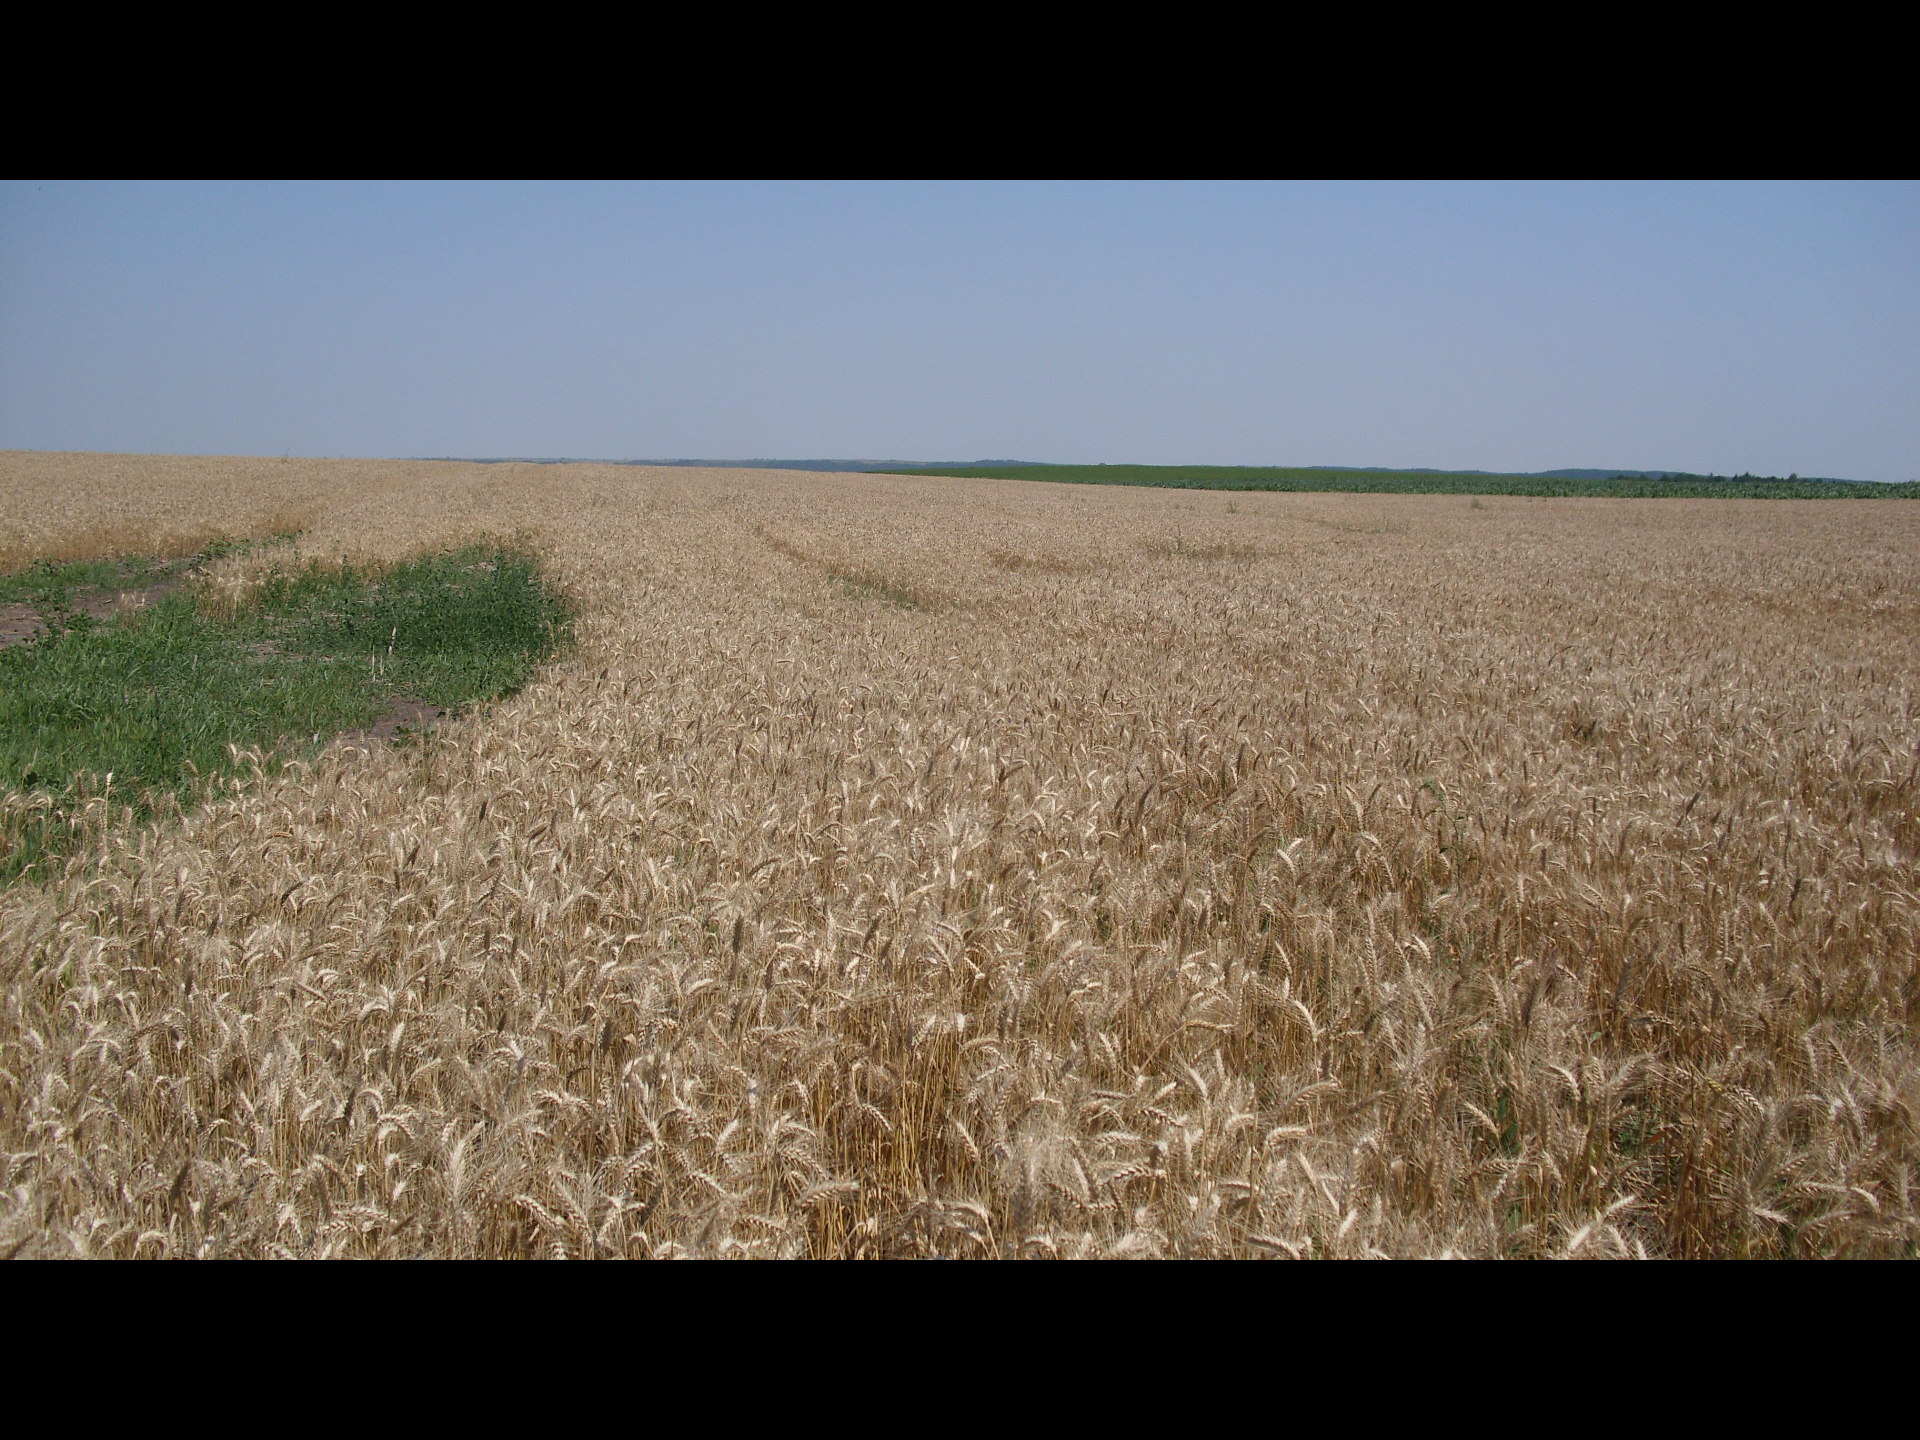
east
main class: Cropland
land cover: Common wheat
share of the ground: > 75 %
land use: Agriculture (excluding fallow land and kitchen gardens)
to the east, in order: Common wheat
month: June
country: BG
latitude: 43.6225
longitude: 23.2650
